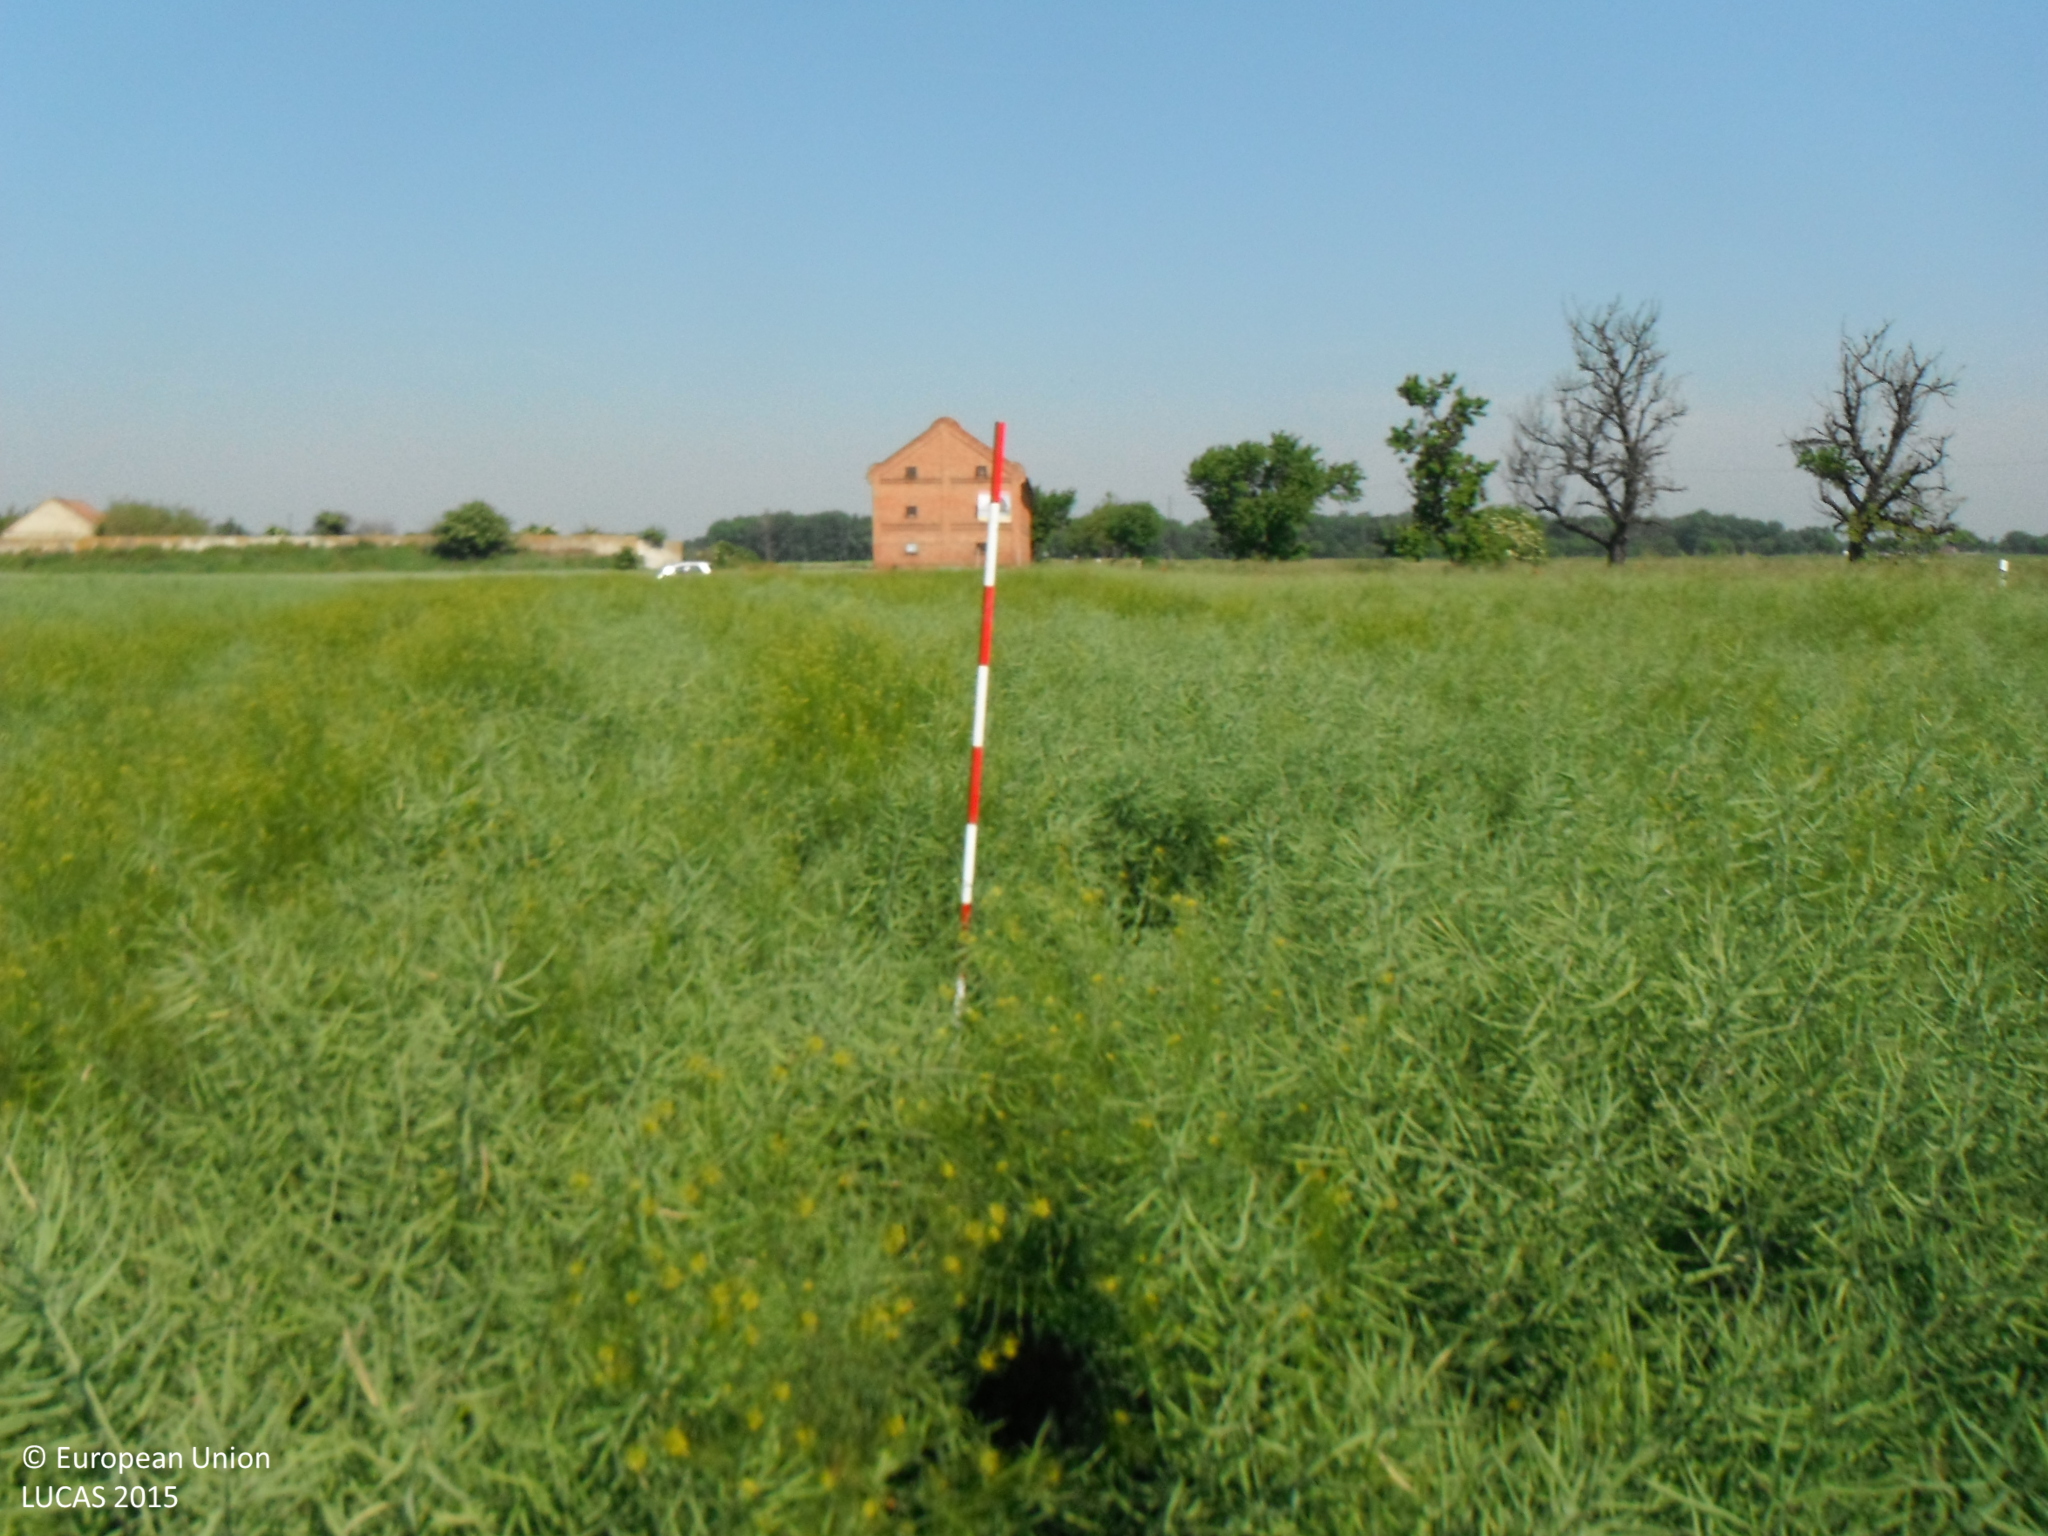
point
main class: Cropland
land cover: Rape and turnip rape
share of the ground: > 75 %
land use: Agriculture (excluding fallow land and kitchen gardens)
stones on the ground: < 10 %
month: May
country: SK
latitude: 47.8168
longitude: 17.8505
